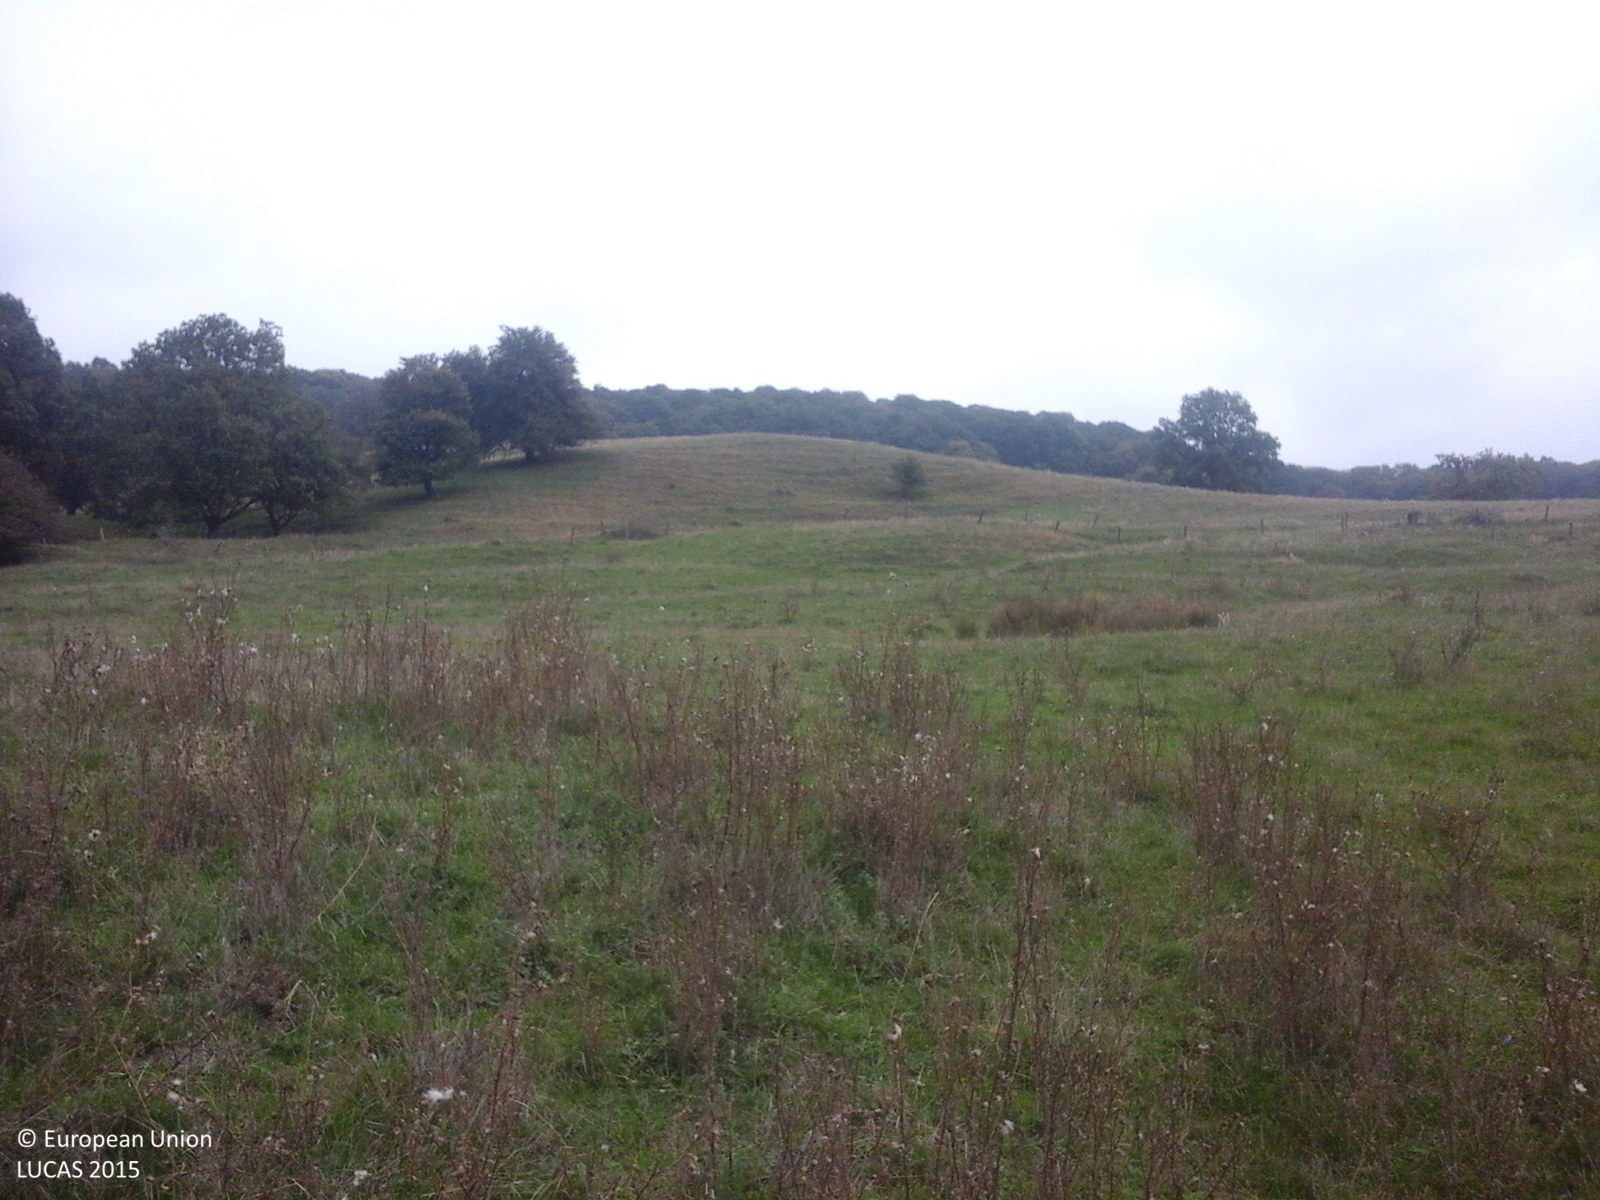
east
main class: Grassland
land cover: Grassland without tree/shrub cover
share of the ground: > 75 %
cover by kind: herbaceous plants 100 %
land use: Agriculture (excluding fallow land and kitchen gardens)
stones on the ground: < 10 %
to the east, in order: Grassland without tree/shrub cover; Grassland with sparse tree/shrub cover; Grassland without tree/shrub cover
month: October
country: RO
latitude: 46.1789
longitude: 24.8996
